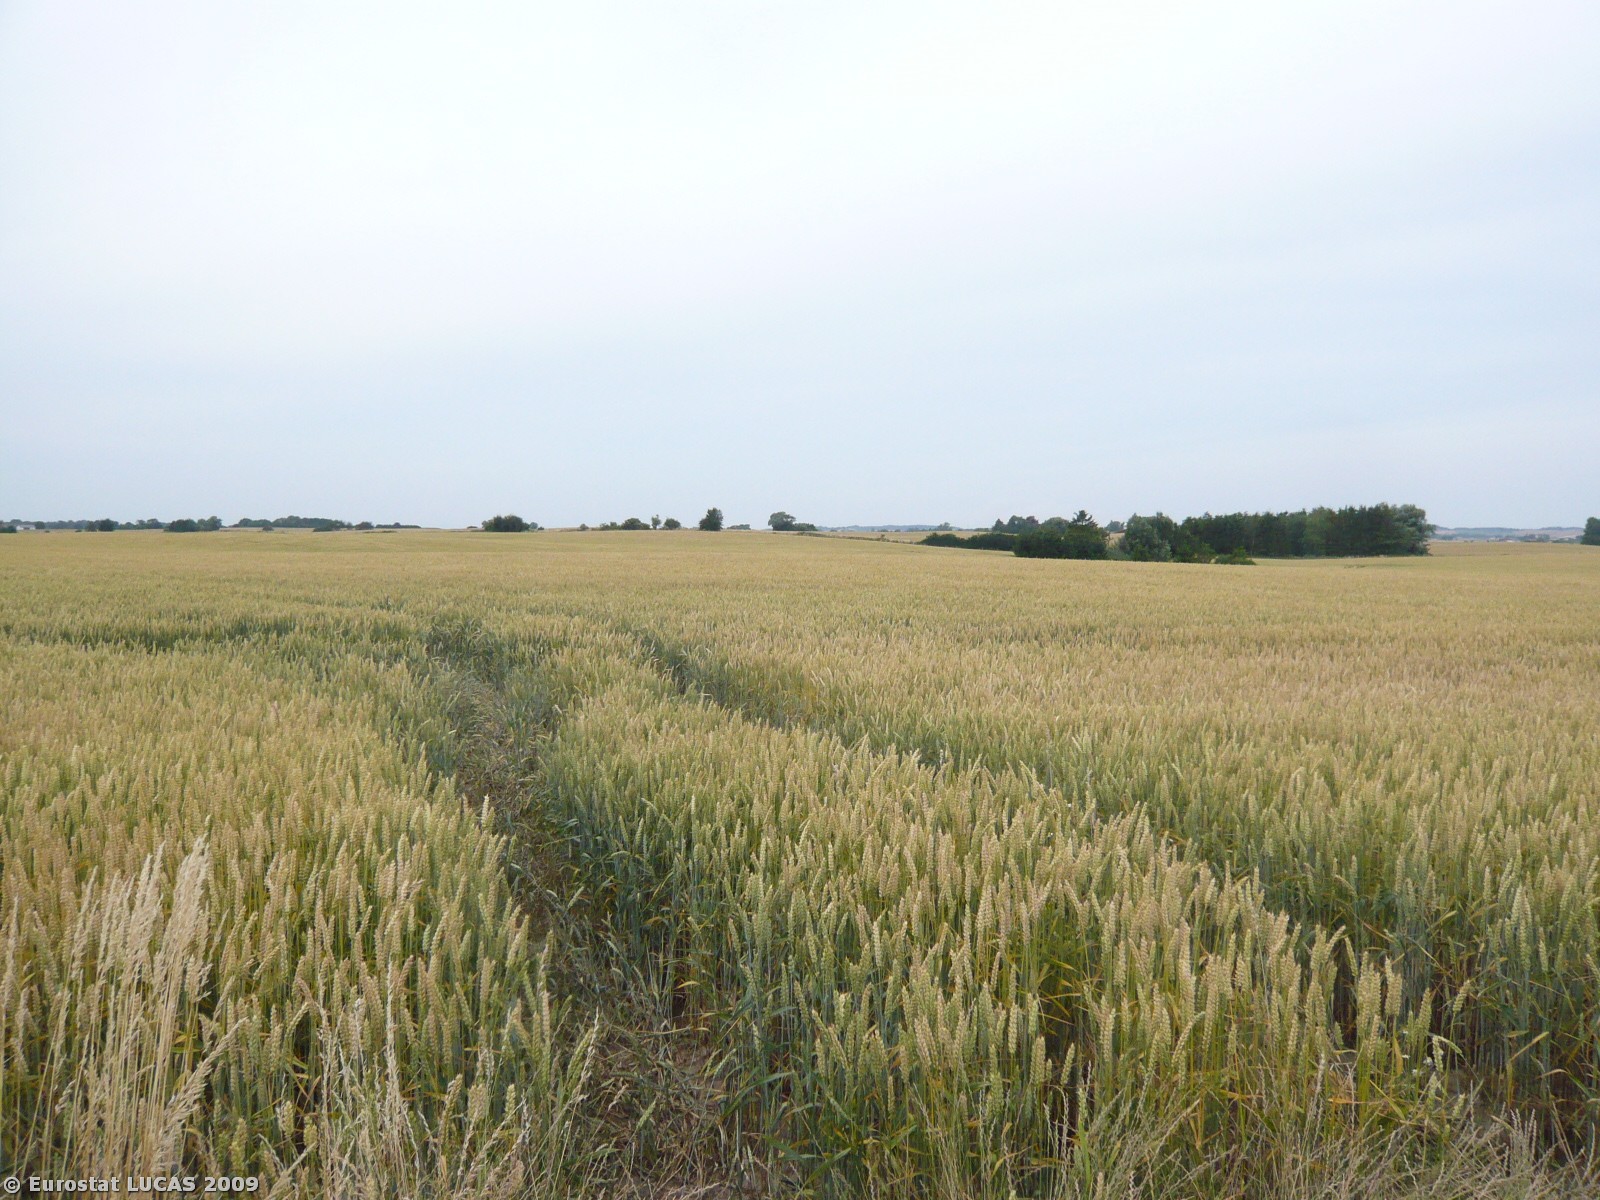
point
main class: Cropland
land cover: Common wheat
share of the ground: > 75 %
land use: Agriculture (excluding fallow land and kitchen gardens)
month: July
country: DK
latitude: 55.5648
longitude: 11.7269
